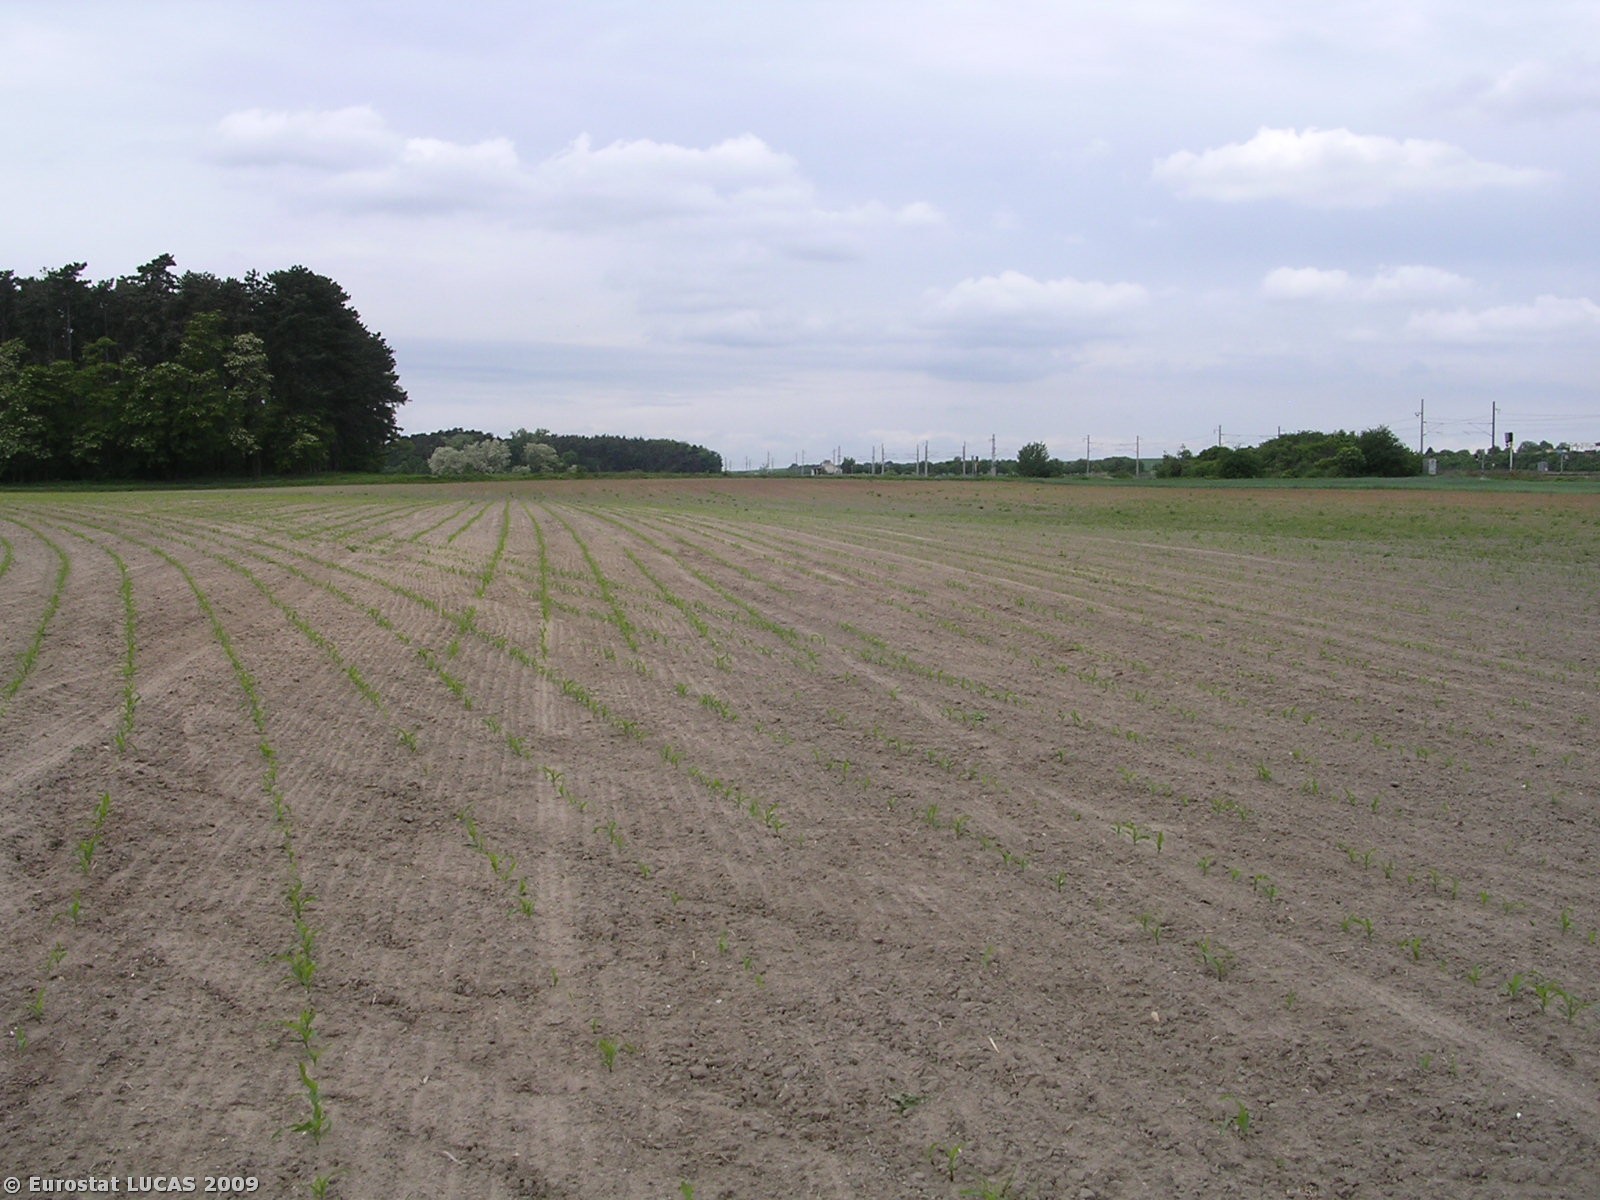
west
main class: Cropland
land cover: Maize
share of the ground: < 10 %
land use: Agriculture (excluding fallow land and kitchen gardens)
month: May
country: CZ
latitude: 50.1863
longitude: 14.9185
